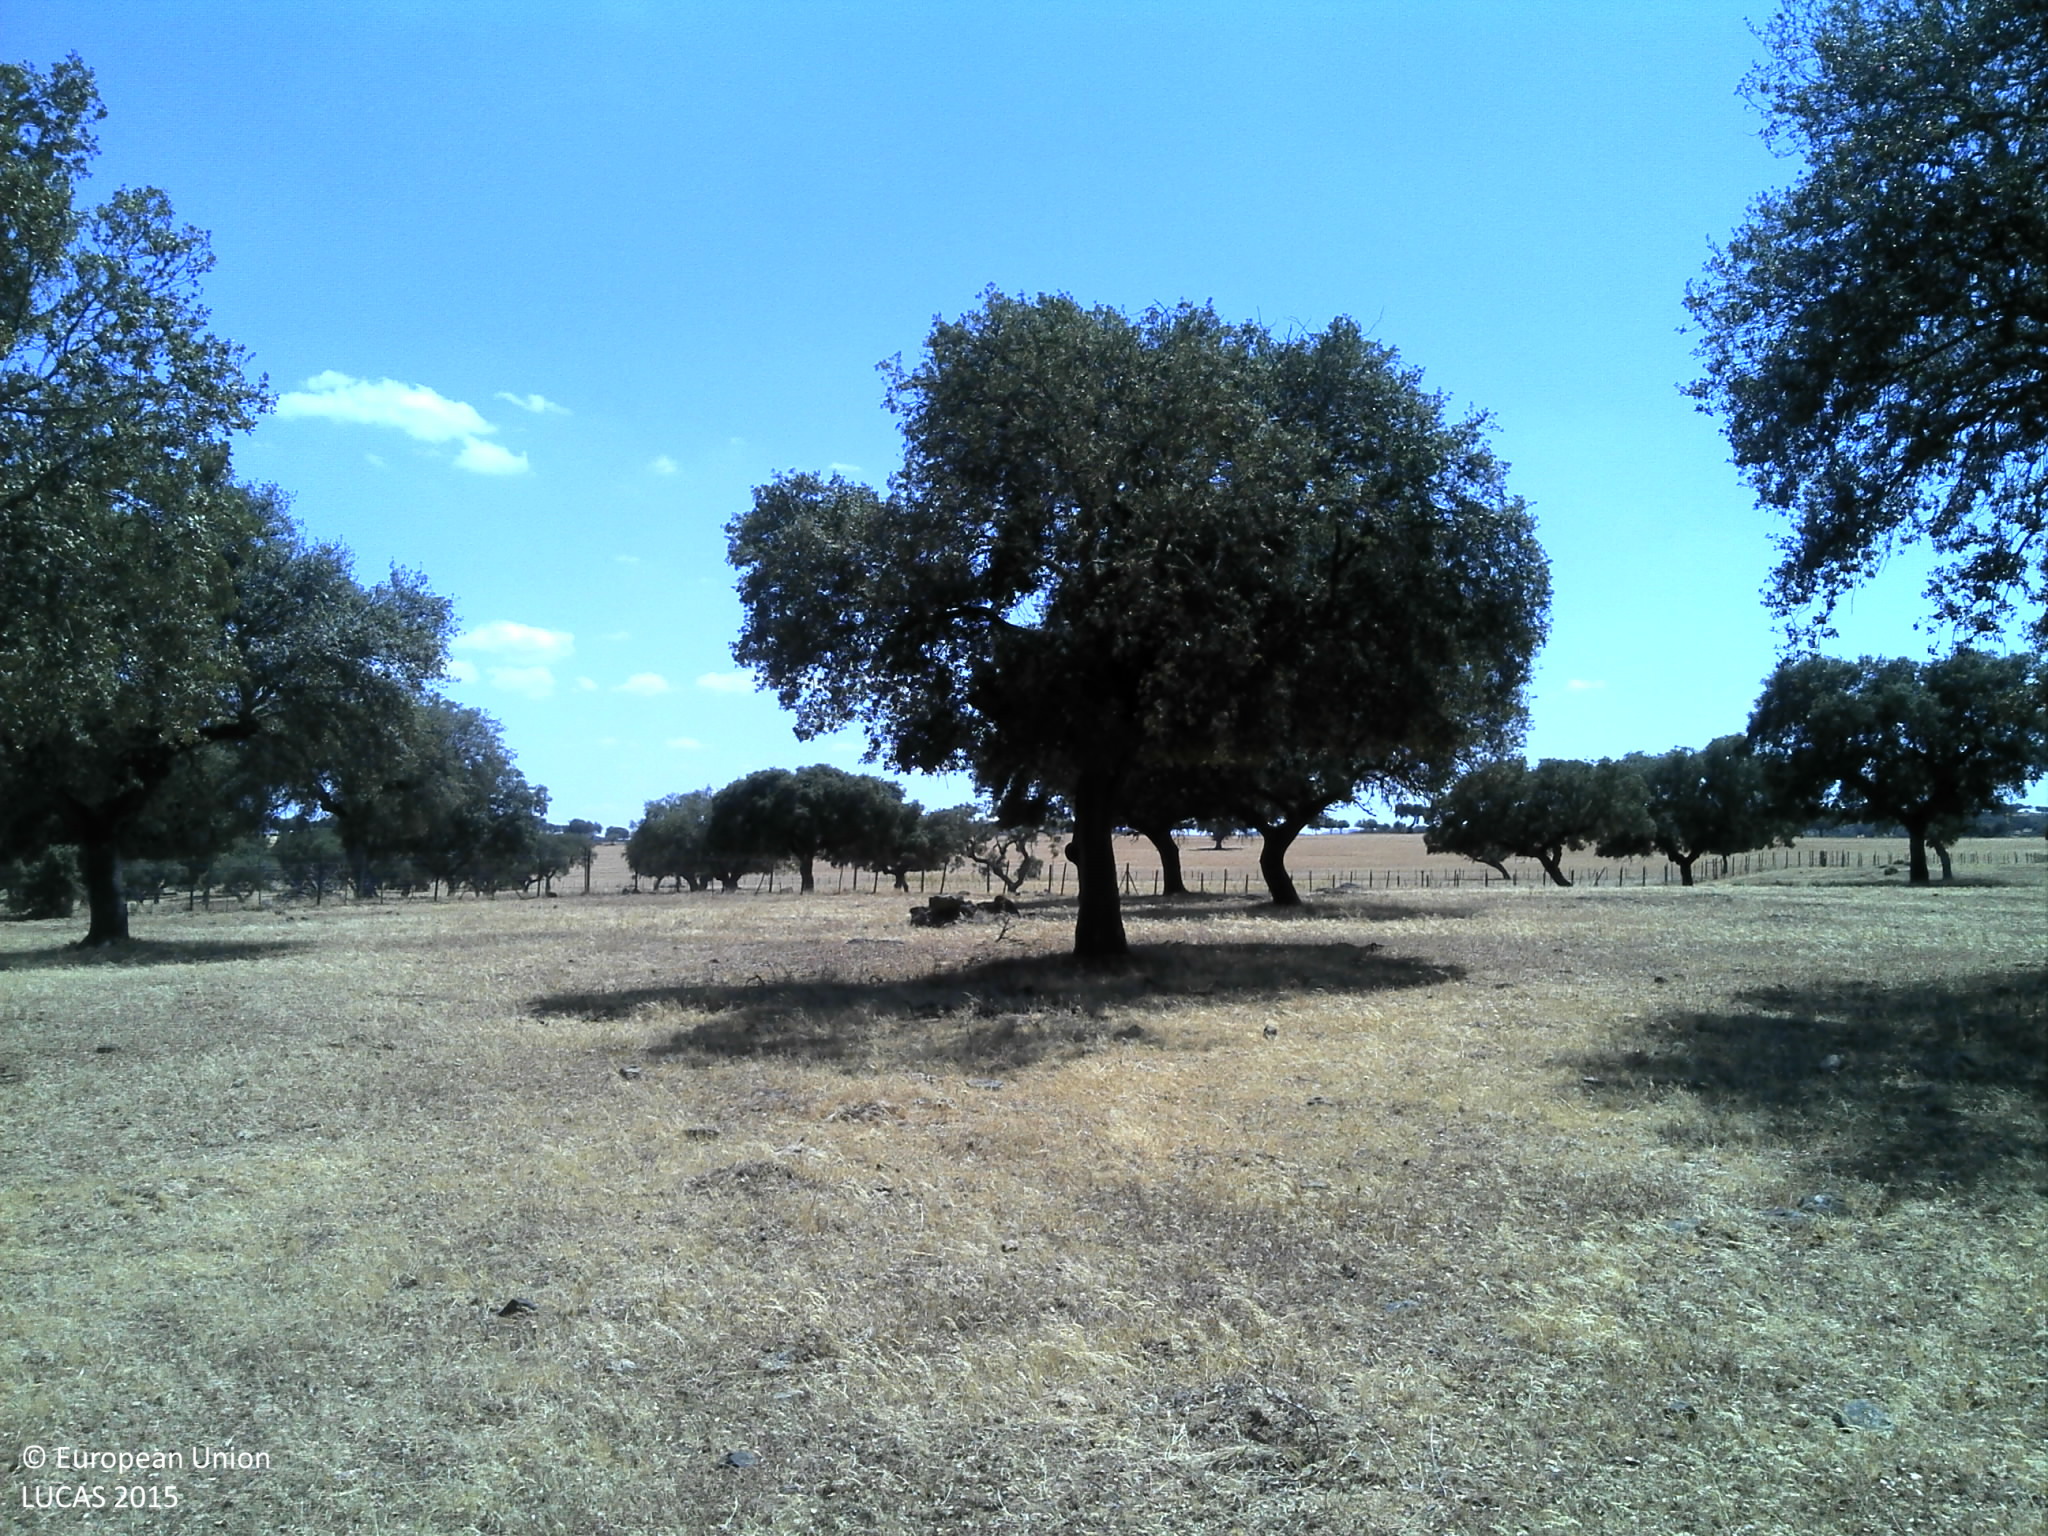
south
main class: Woodland
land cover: Broadleaved woodland
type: broadleaved evergreen forest
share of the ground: 10 - 25 %
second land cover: Grassland without tree/shrub cover
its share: 10 - 25 %
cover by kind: unconsolidated bare surface 60 %, broadleaved forest trees 20 %, herbaceous plants 20 %
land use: Forestry
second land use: Agriculture (excluding fallow land and kitchen gardens)
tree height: > 5 m
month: July
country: PT
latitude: 38.8028
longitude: -7.3372
